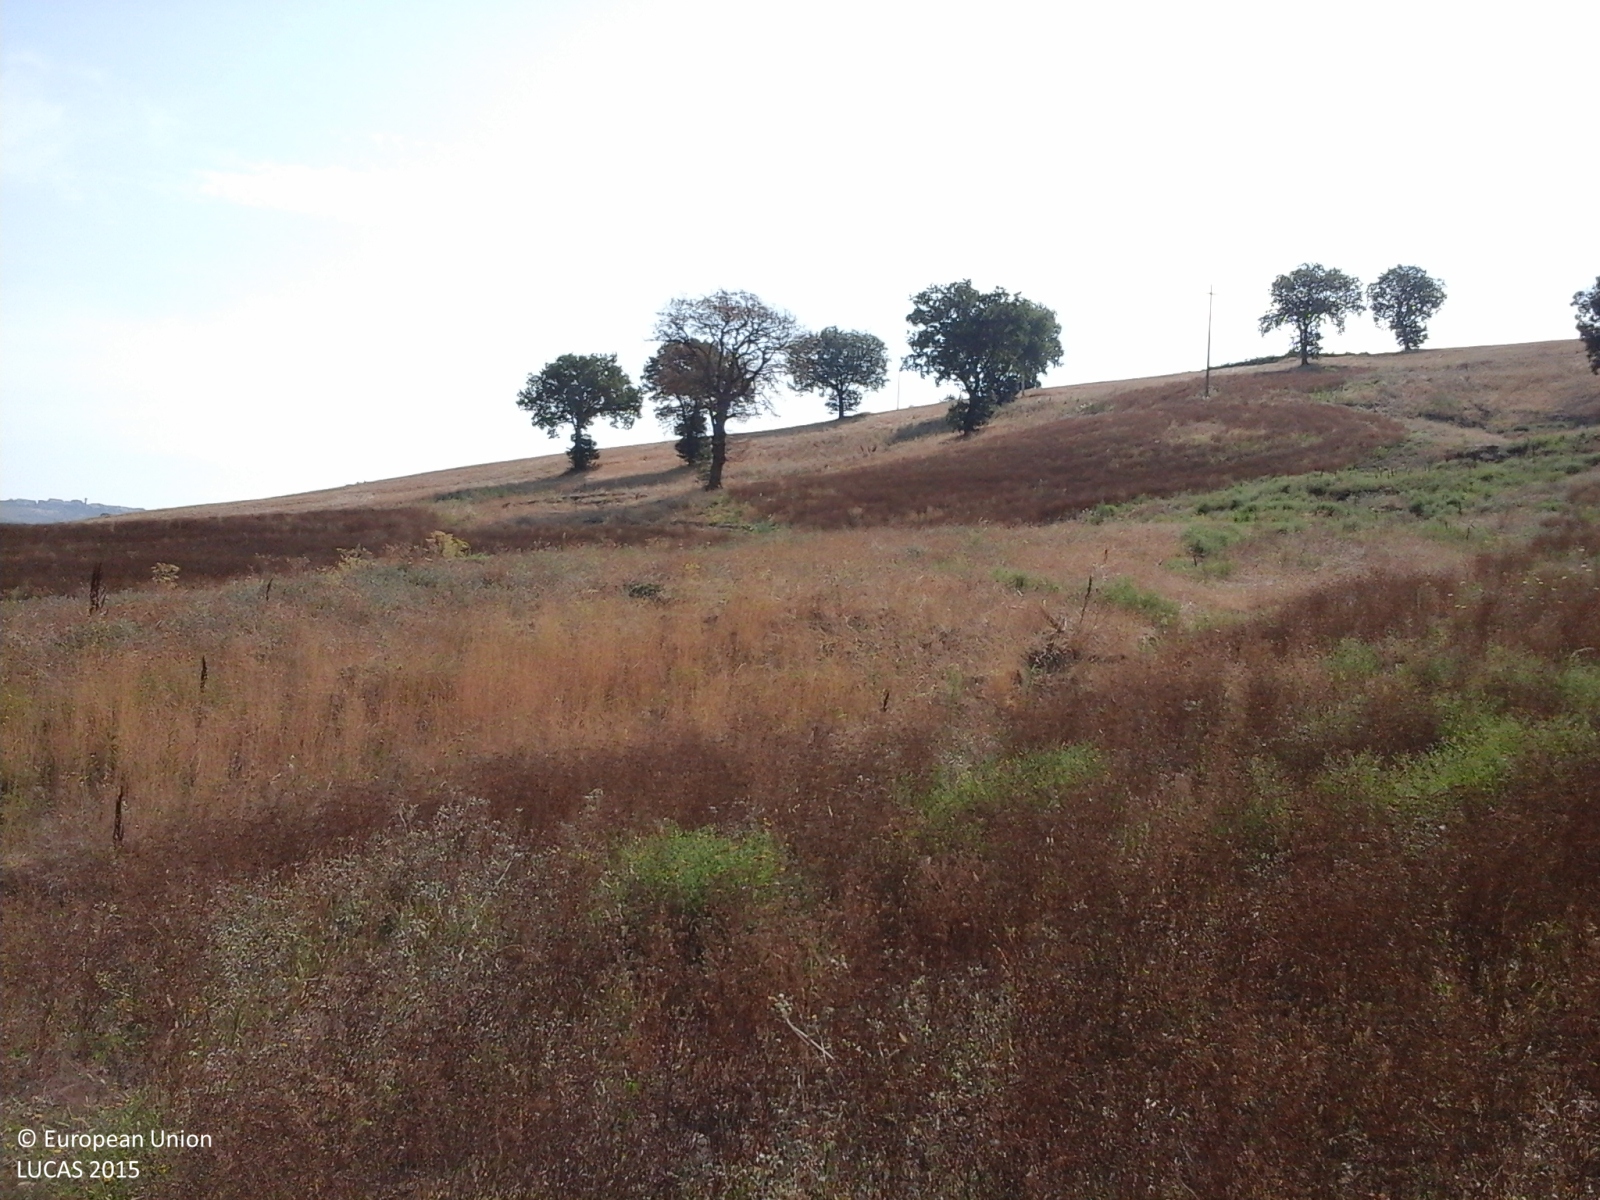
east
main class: Cropland
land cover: Other non-permanent industrial crops
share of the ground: > 75 %
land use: Agriculture (excluding fallow land and kitchen gardens)
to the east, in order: Other non-permanent industrial crops; Spontaneously vegetated surfaces; Other non-permanent industrial crops; Spontaneously vegetated surfaces; Durum wheat; Electric lines; Durum wheat
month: August
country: IT
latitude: 41.8926
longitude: 14.7215
